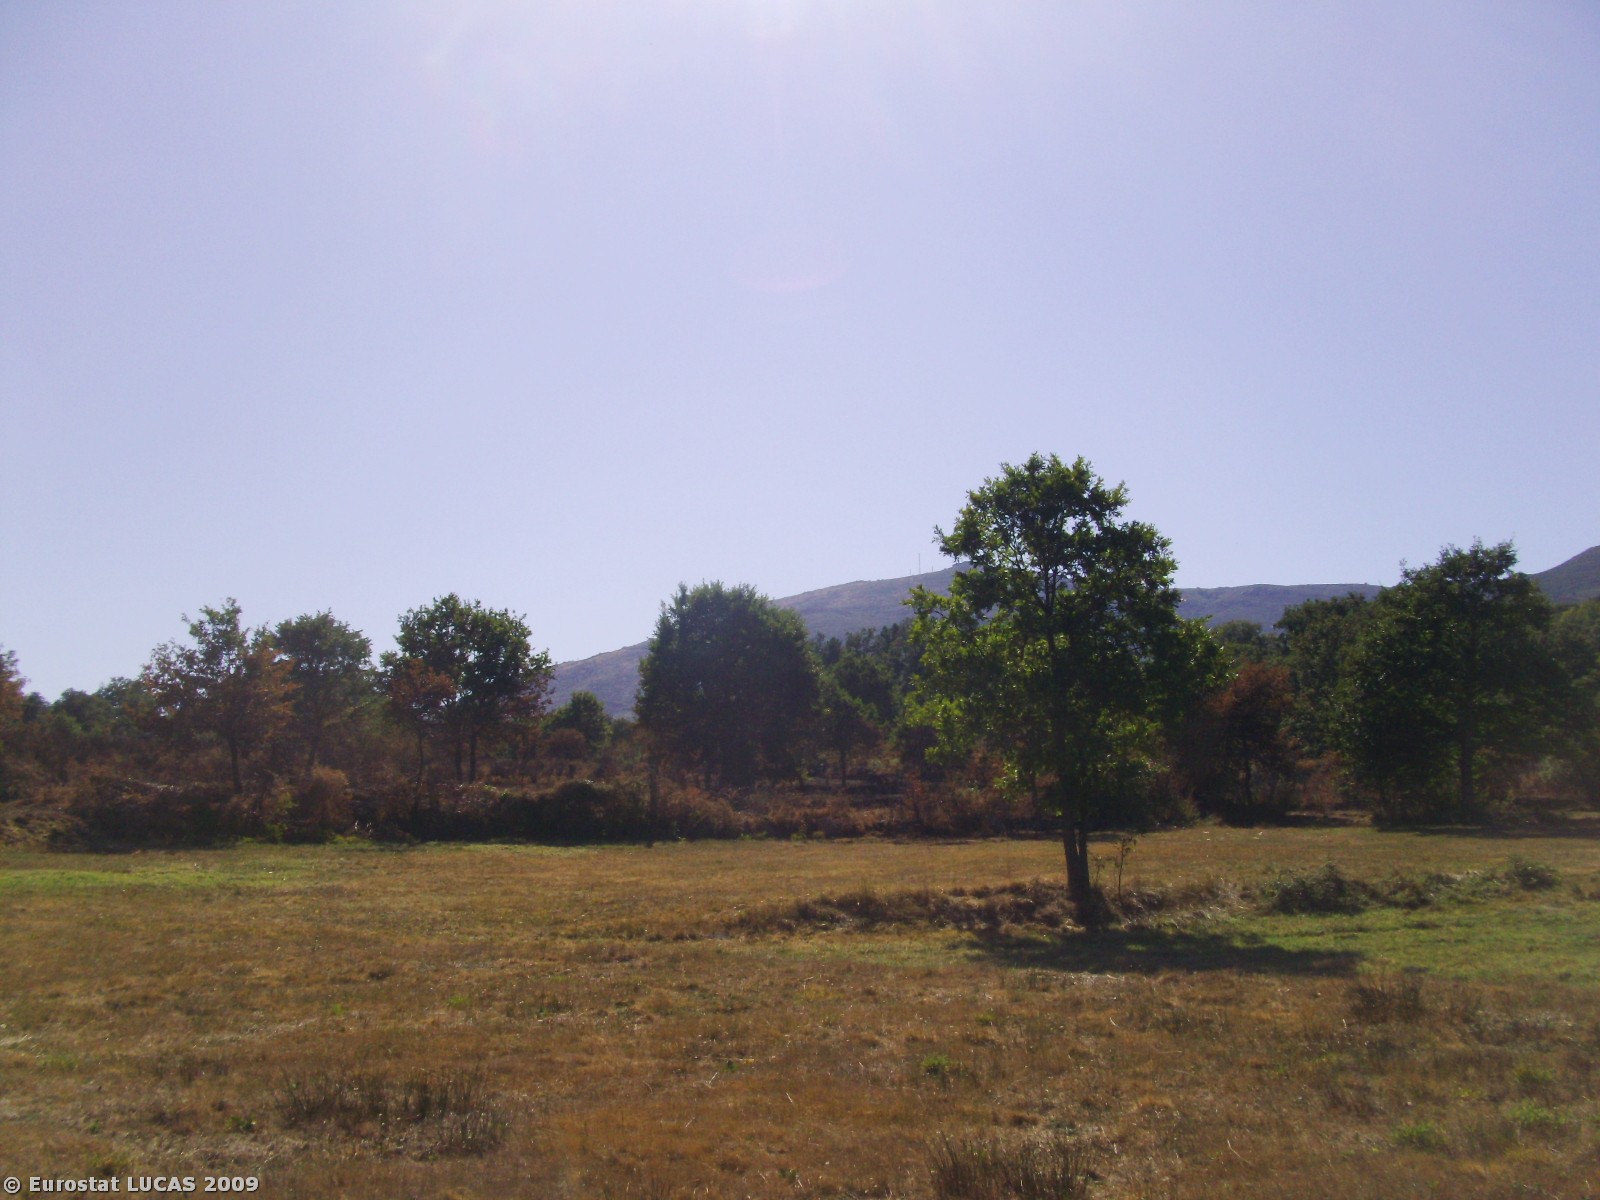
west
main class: Grassland
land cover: Spontaneously vegetated surfaces
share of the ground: > 75 %
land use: Fallow land
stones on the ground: < 10 %
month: August
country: PT
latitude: 41.7430
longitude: -7.6054
